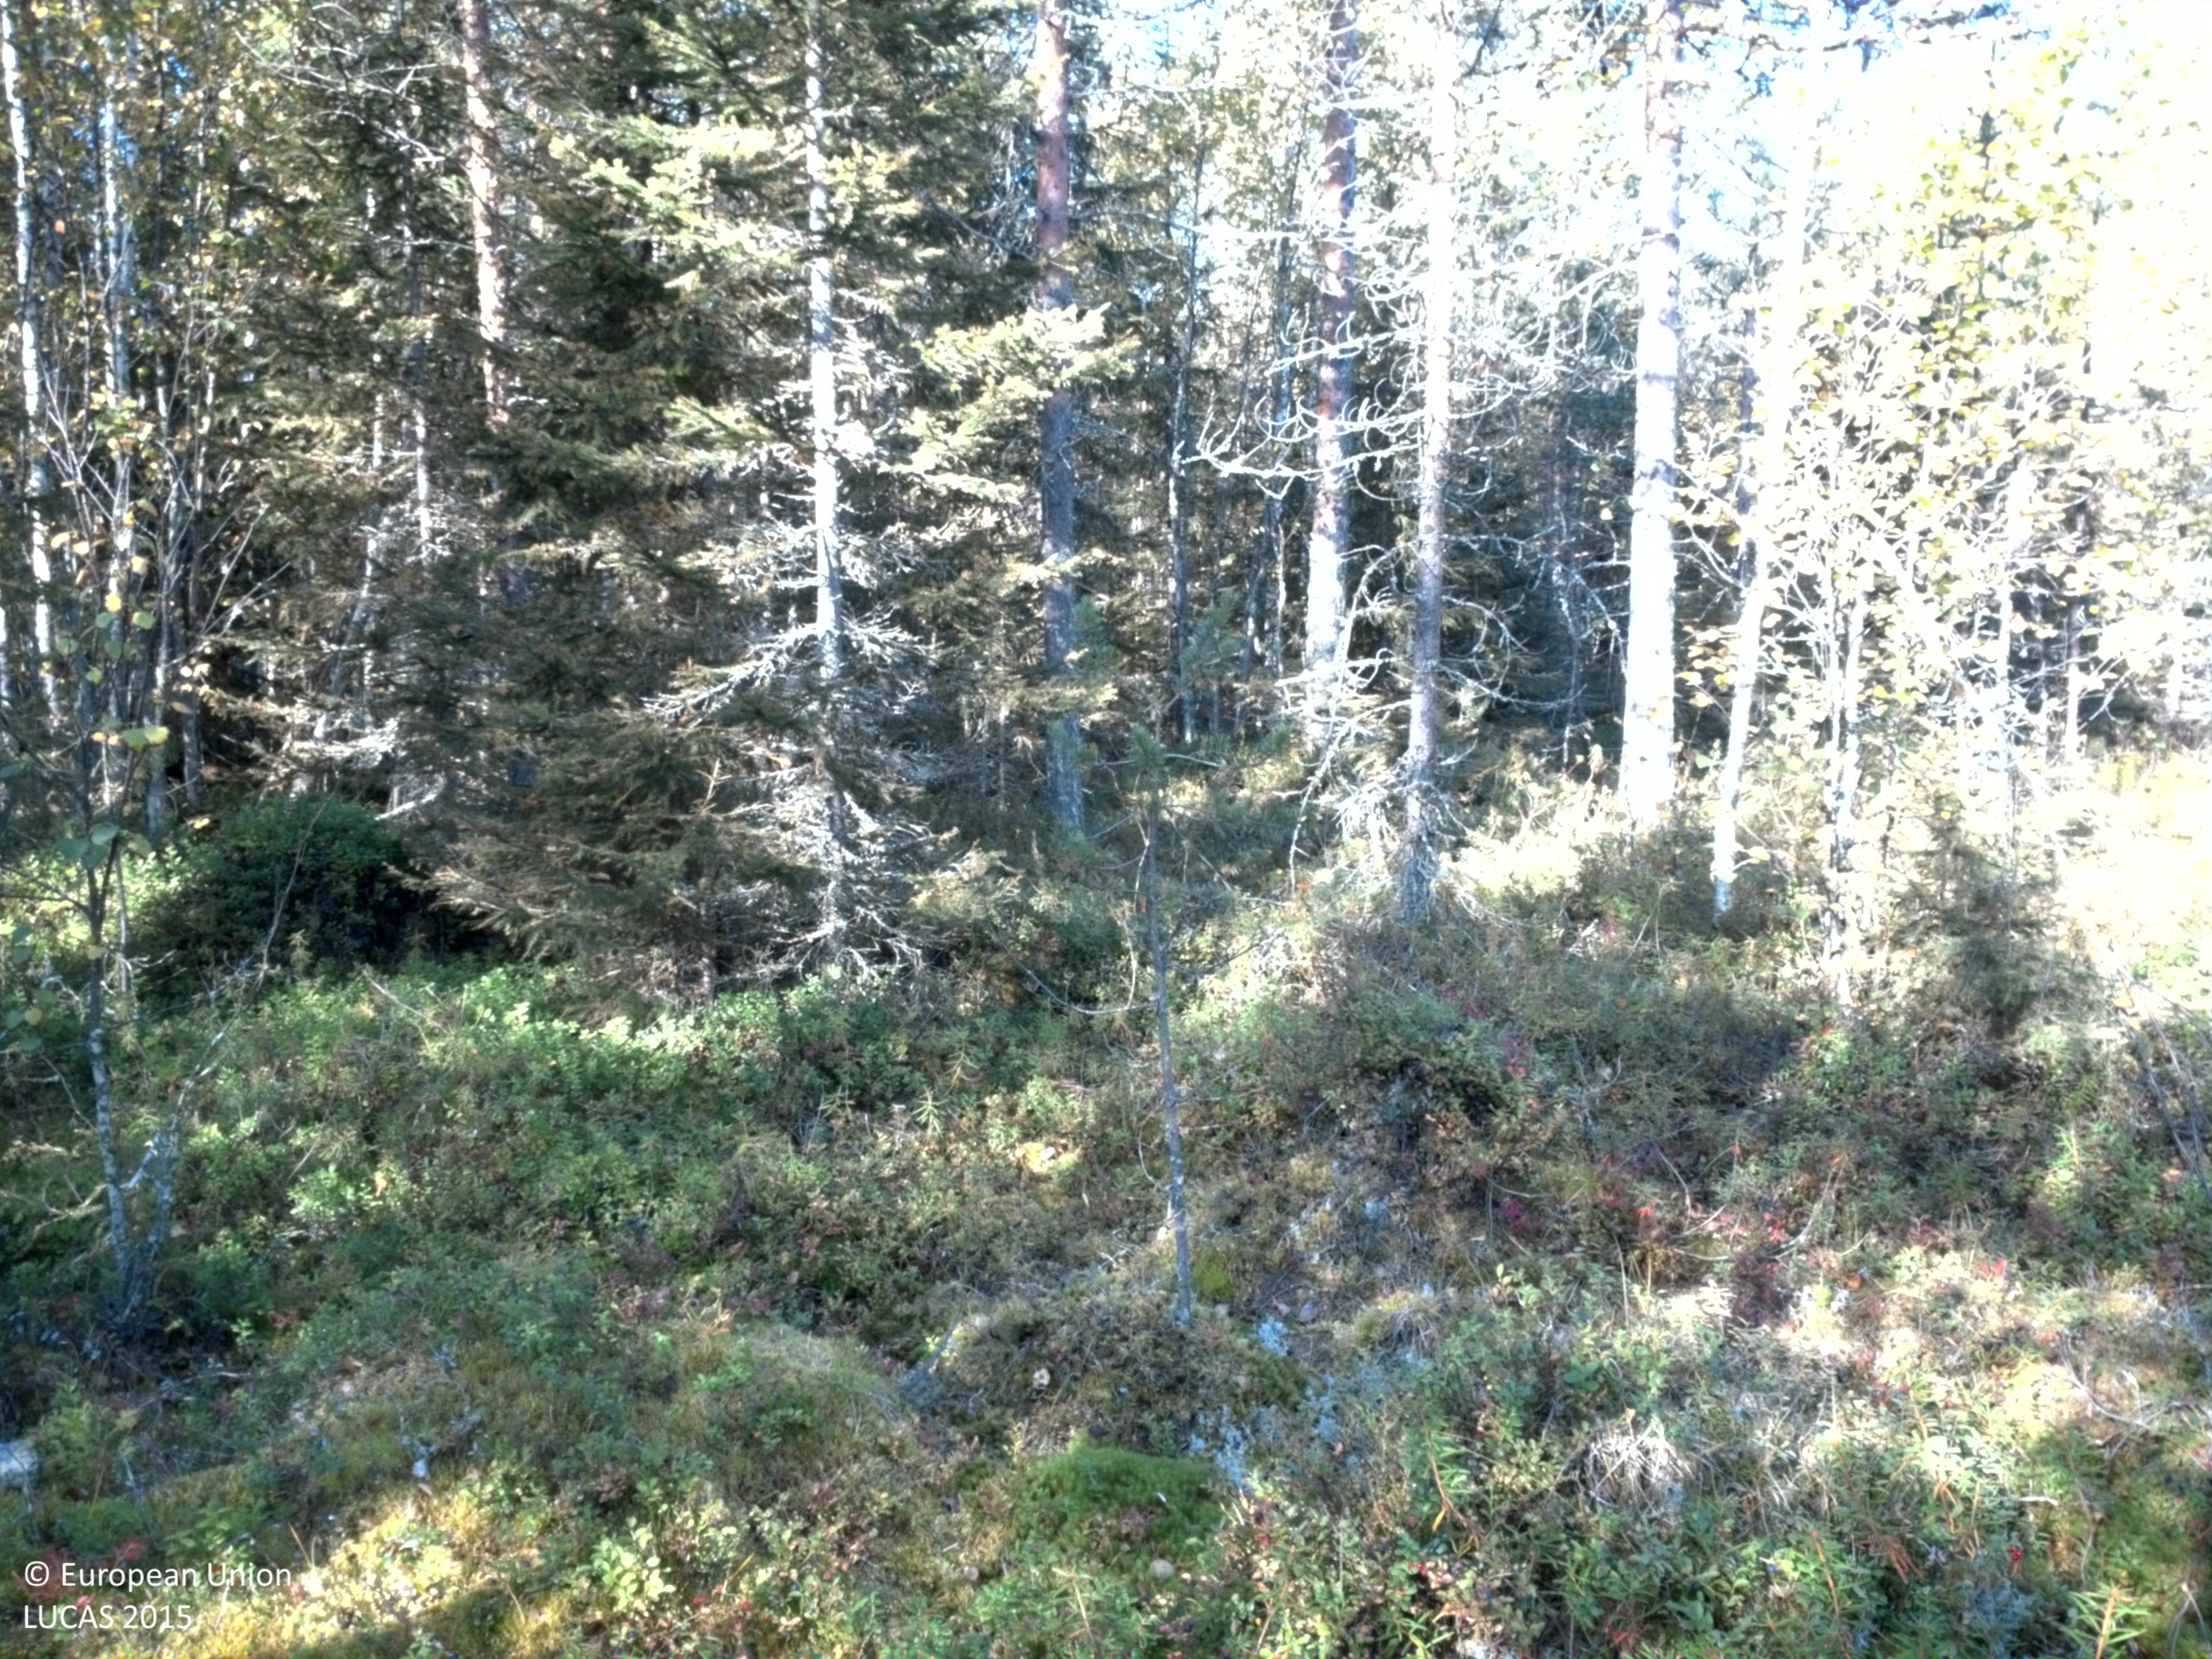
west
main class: Woodland
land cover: Pine dominated mixed woodland
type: boreal forest
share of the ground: 25 - 50 %
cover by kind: shrubs 60 %, coniferous forest trees 25 %, broadleaved forest trees 10 %, lichens and mosses 5 %
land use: Forestry
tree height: > 5 m
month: September
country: SE
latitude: 65.8523
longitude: 22.1787
